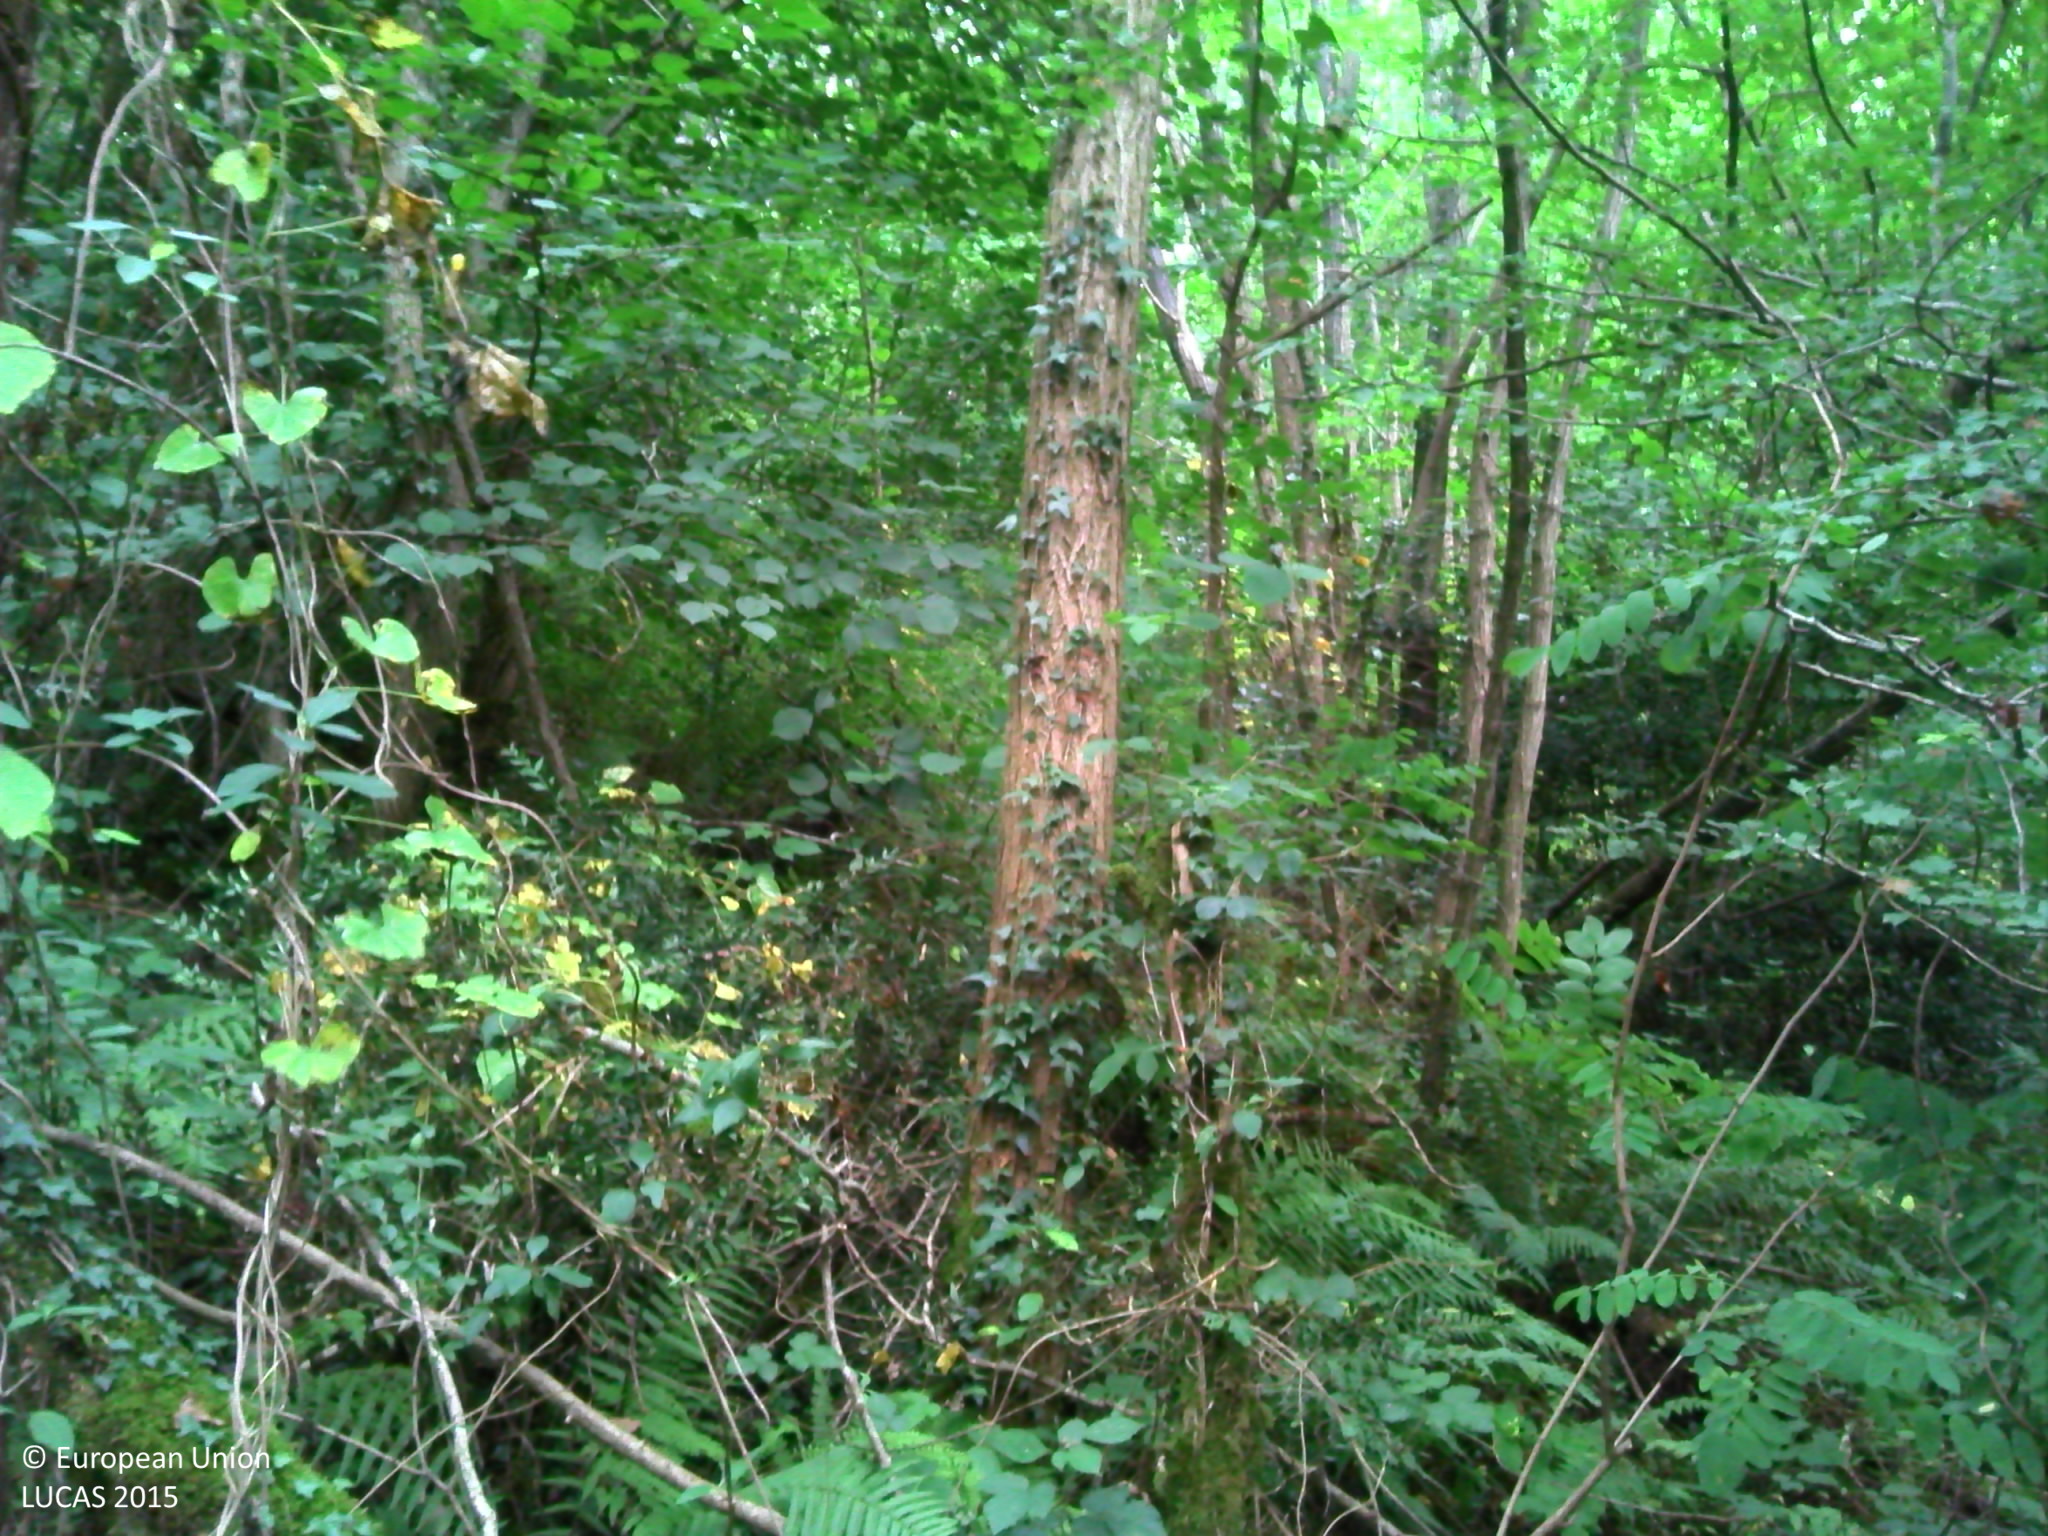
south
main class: Woodland
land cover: Broadleaved woodland
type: thermophilous deciduous forest
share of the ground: > 75 %
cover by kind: broadleaved forest trees 80 %, shrubs 10 %, herbaceous plants 5 %, lichens and mosses 5 %
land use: Forestry
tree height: > 5 m
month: August
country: FR
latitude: 43.3371
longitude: -1.0771
